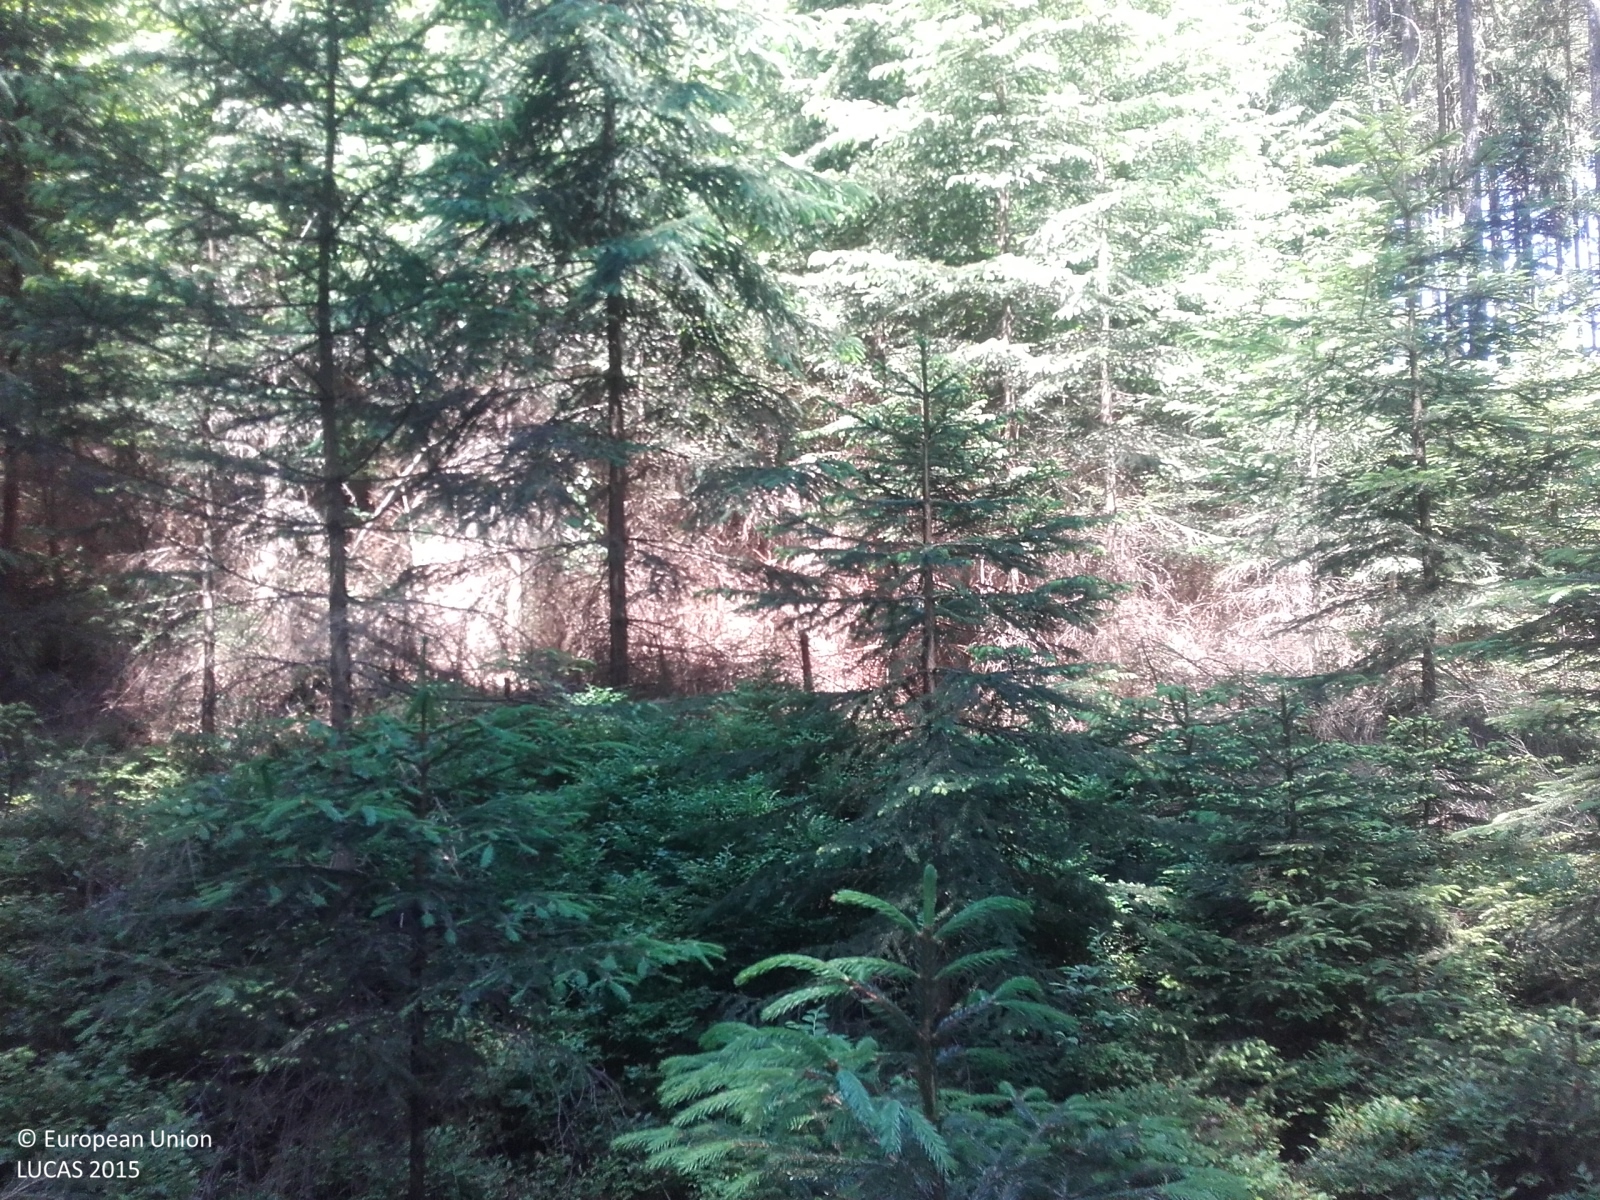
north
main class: Woodland
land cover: Spruce dominated coniferous woodland
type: hemiboreal forest and nemoral coniferous forest and mixed broadleaved-coniferous forest
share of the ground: > 75 %
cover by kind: coniferous forest trees 95 %, herbaceous plants 5 %
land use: Forestry
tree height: > 5 m
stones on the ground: < 10 %
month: June
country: CZ
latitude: 49.5049
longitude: 18.7339
